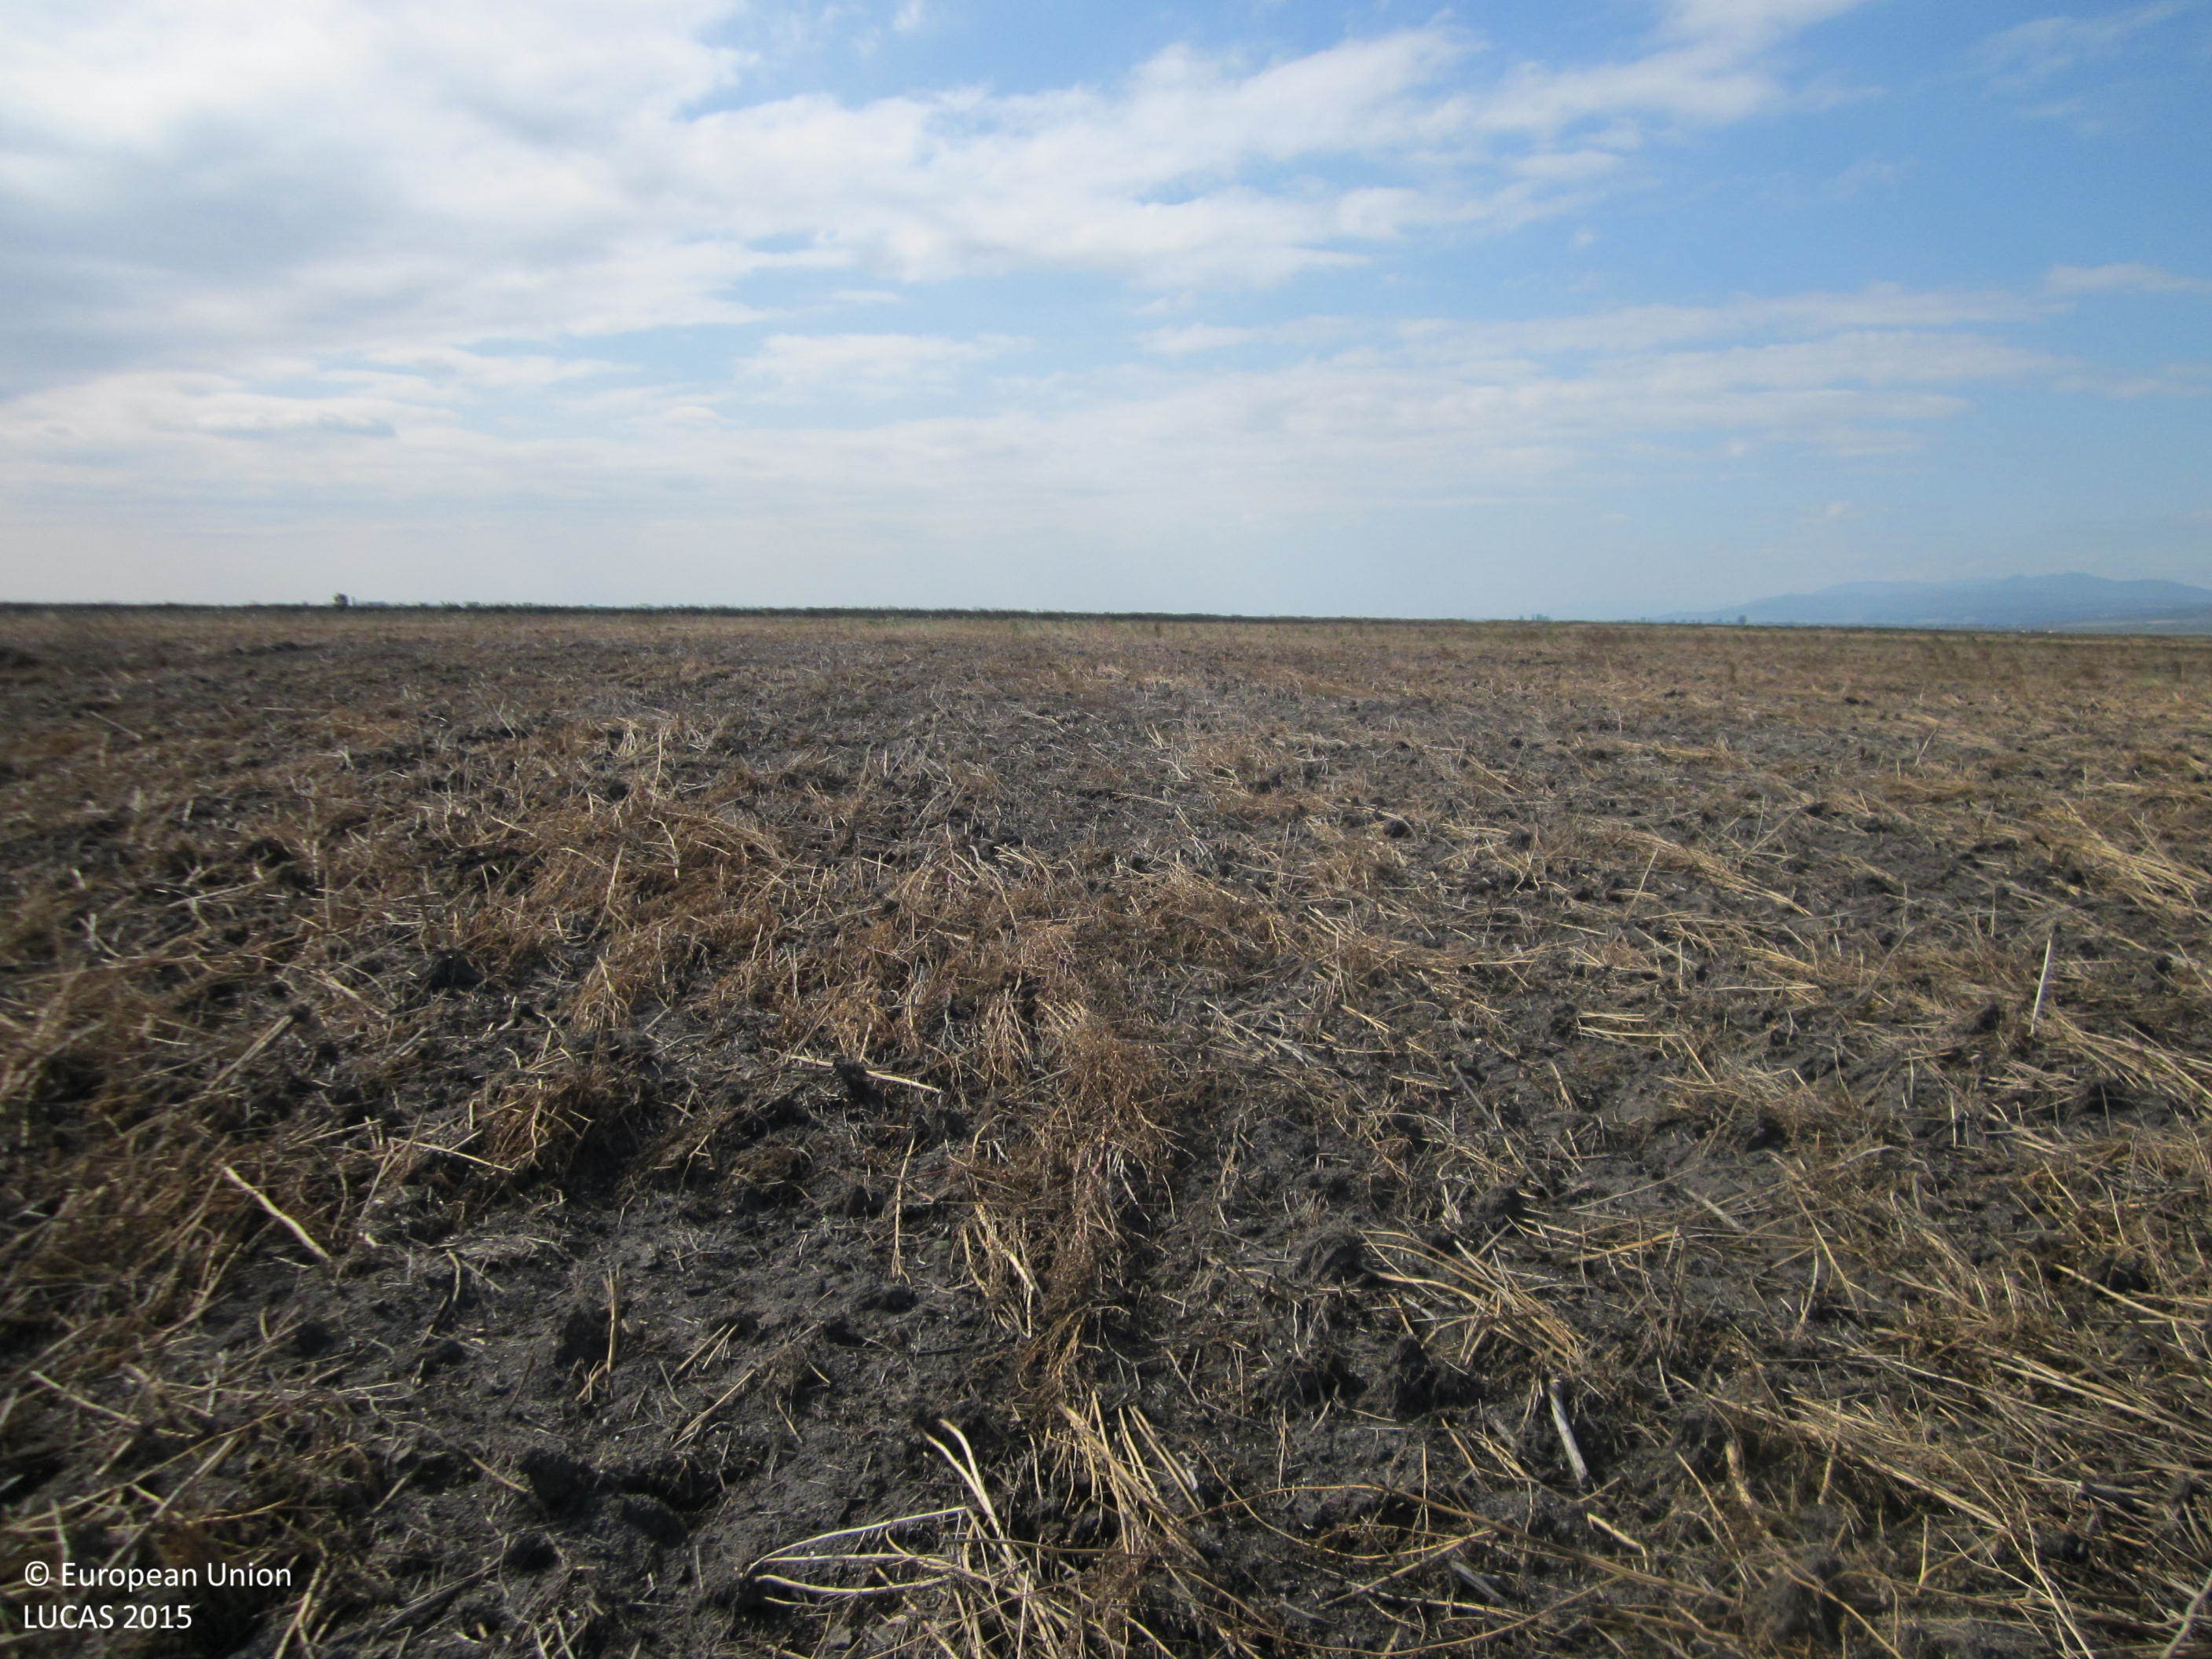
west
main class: Cropland
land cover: Sunflower
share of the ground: 10 - 25 %
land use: Agriculture (excluding fallow land and kitchen gardens)
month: October
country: BG
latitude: 42.6207
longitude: 26.7918
